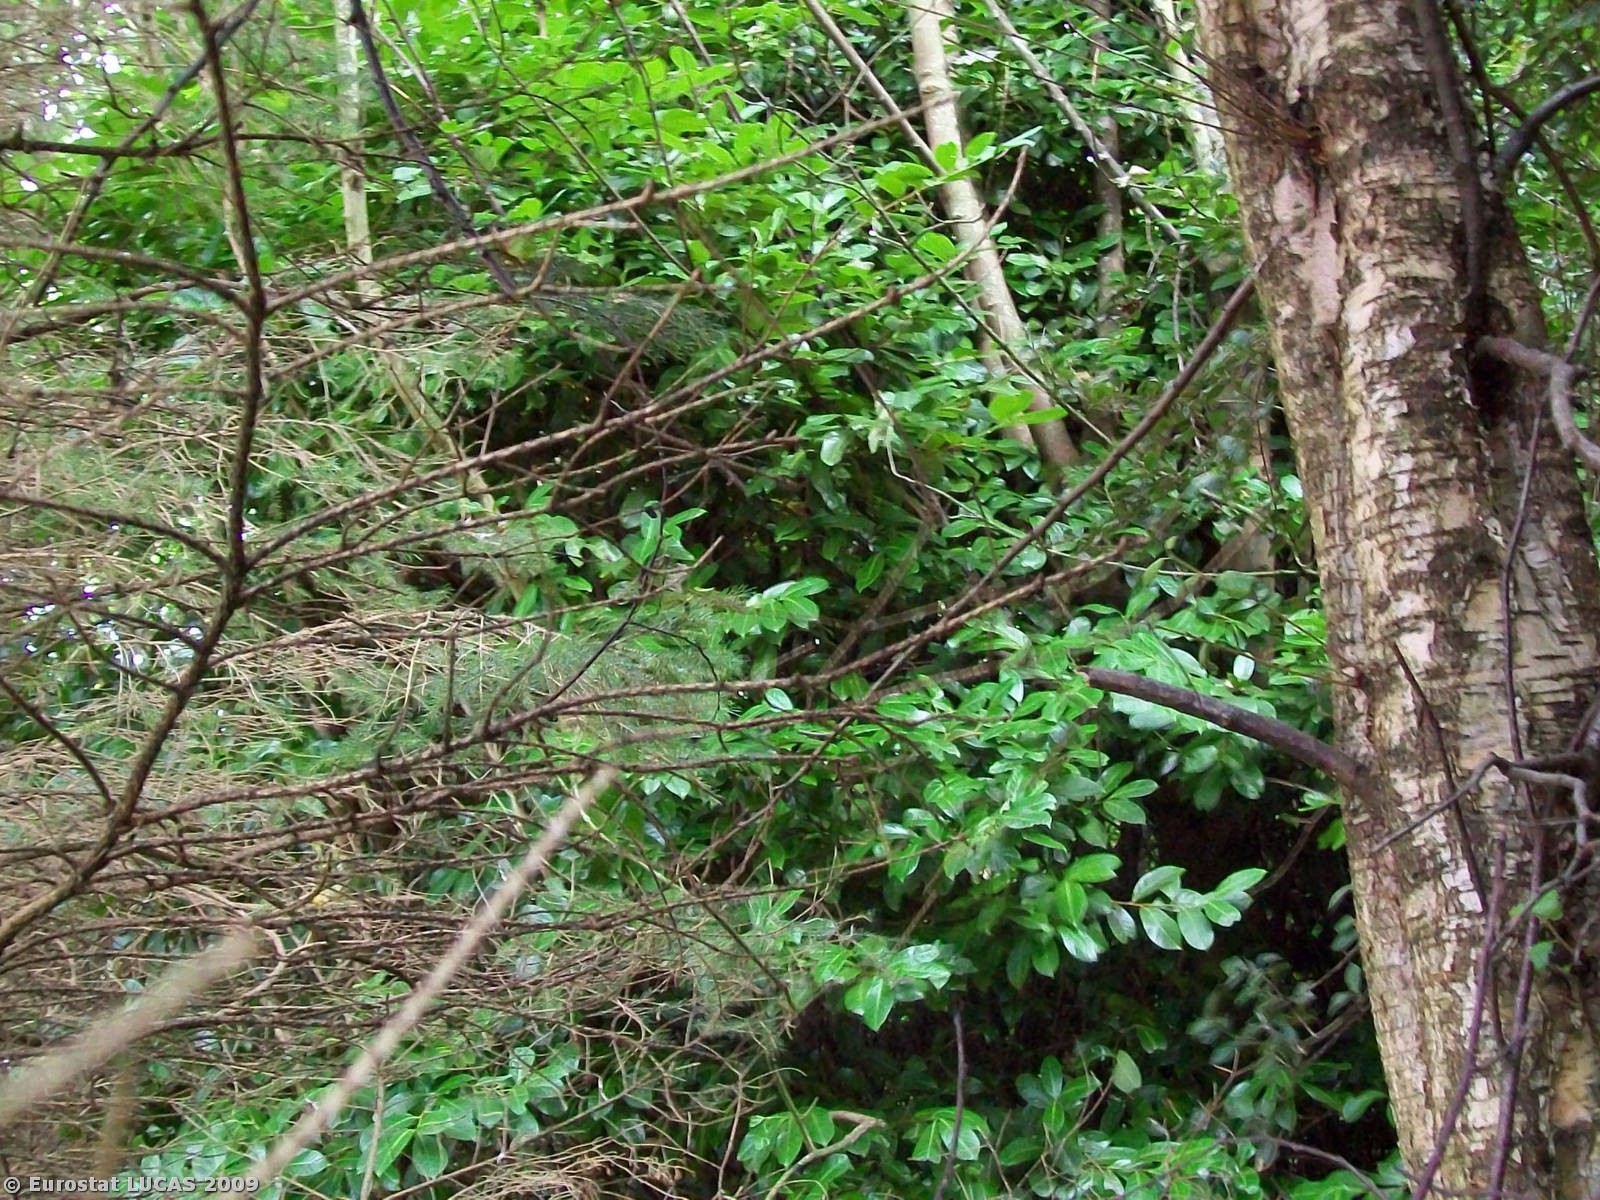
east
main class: Cropland
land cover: Arable land (only in case pi)
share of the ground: > 75 %
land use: Agriculture (excluding fallow land and kitchen gardens)
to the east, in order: Mixed woodland; Broadleaved woodland; Conifer hedges; Bare land; Electric lines; Bare land
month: September
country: GB
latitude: 55.7914
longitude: -2.3218
